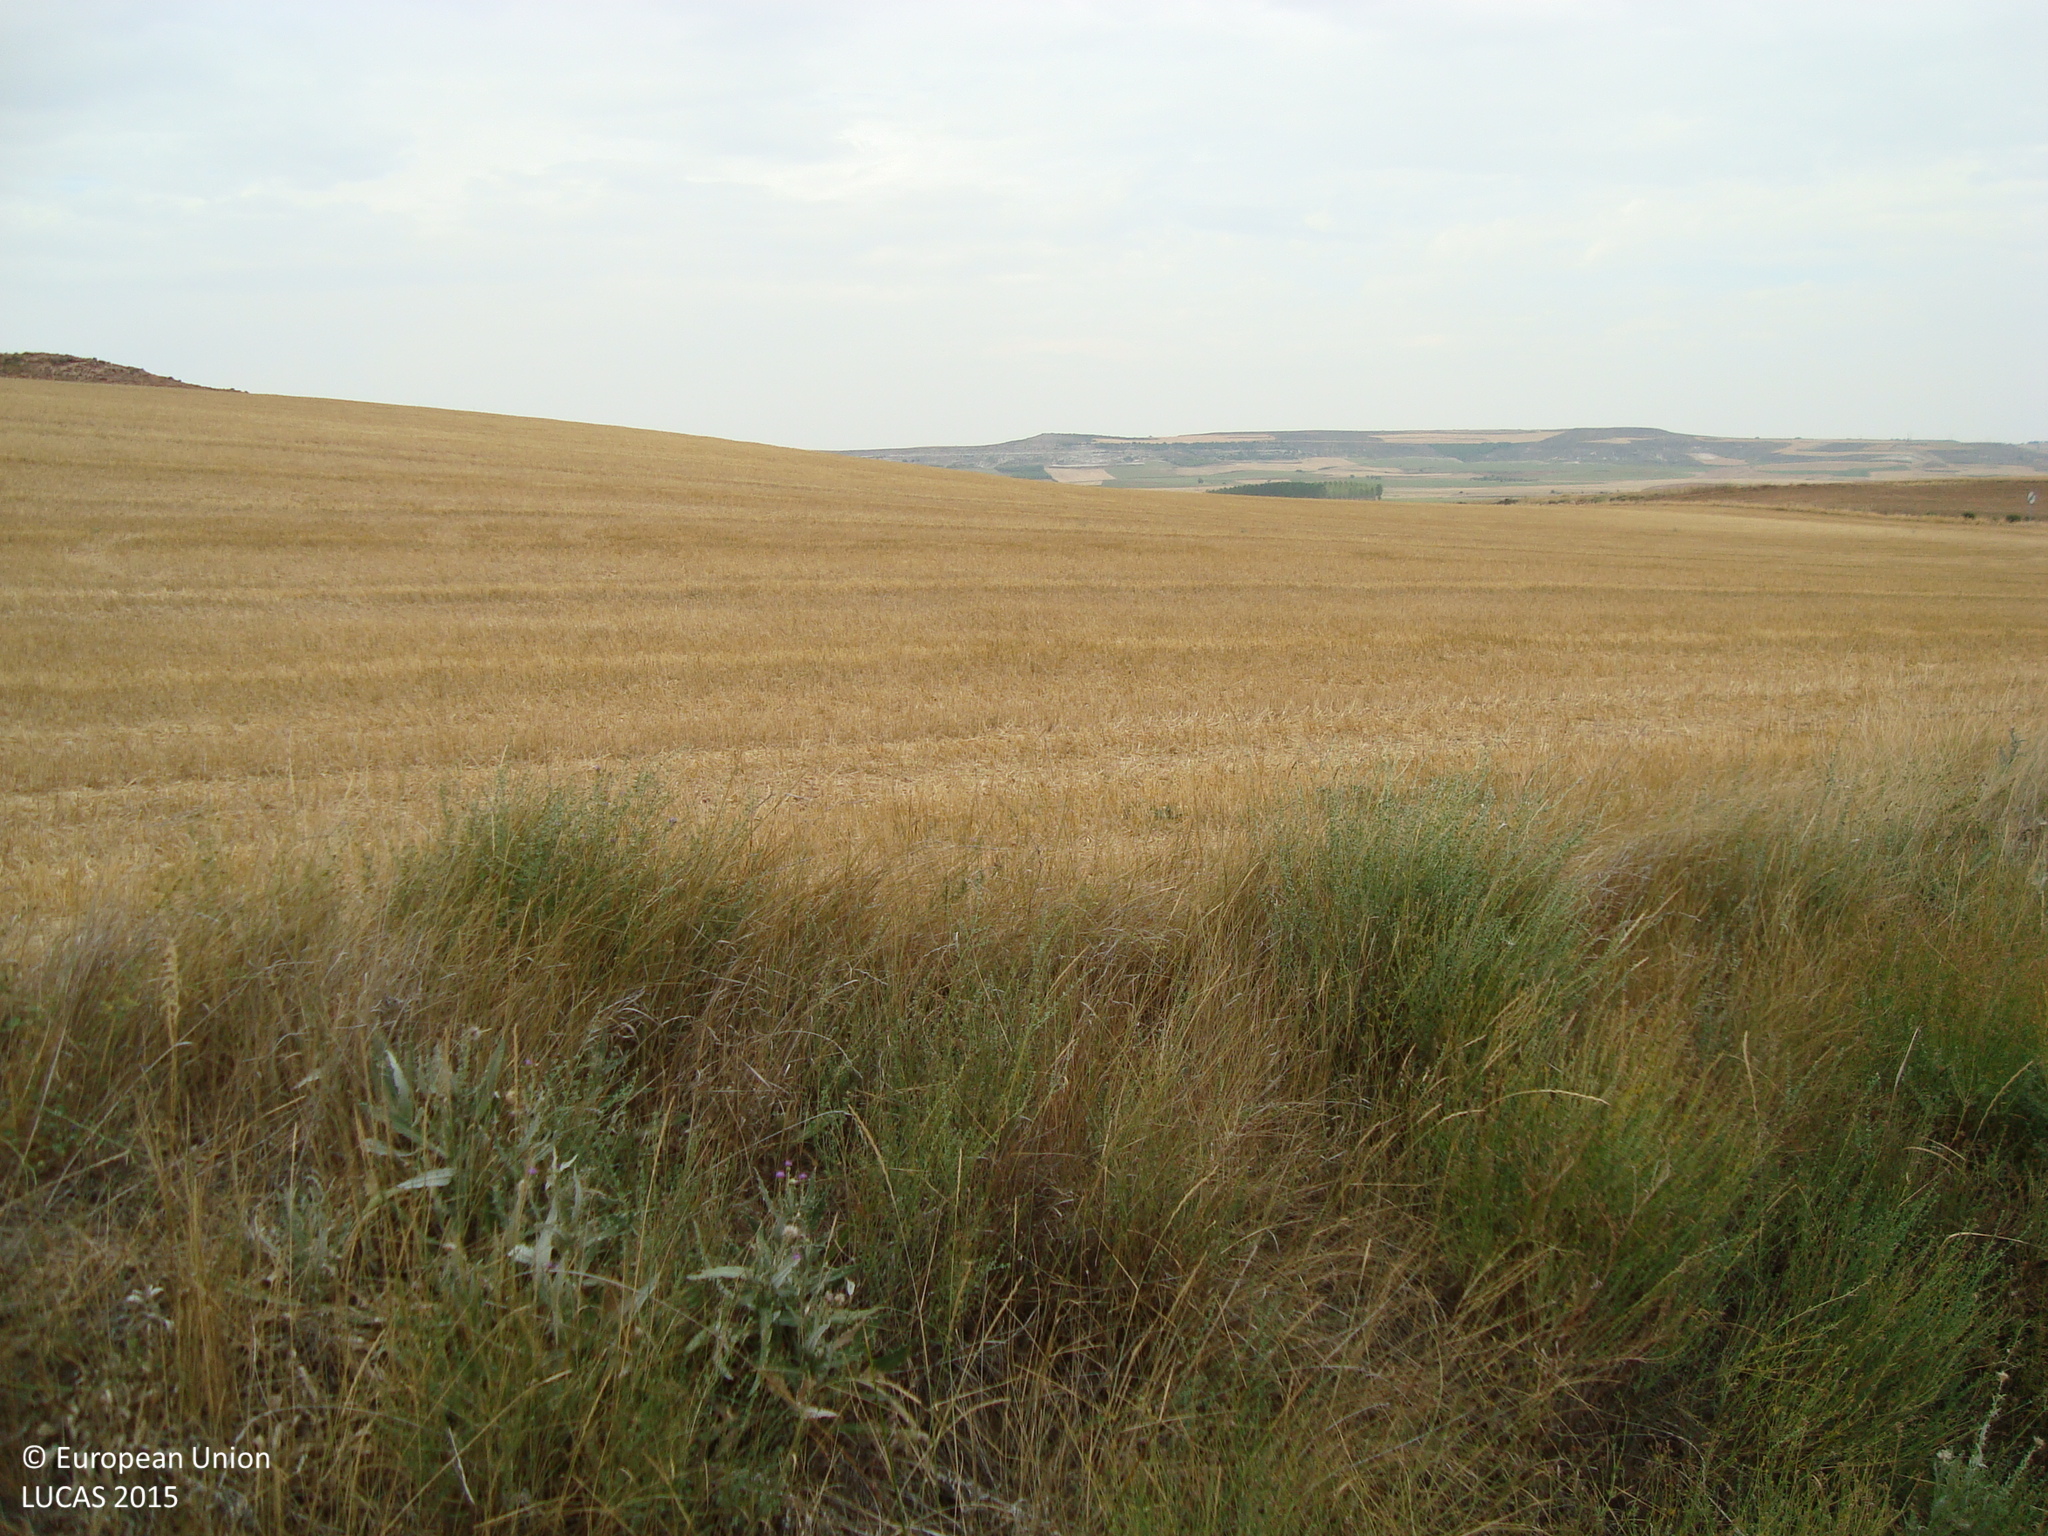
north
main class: Cropland
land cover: Barley
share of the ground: > 75 %
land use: Agriculture (excluding fallow land and kitchen gardens)
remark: Harvested field
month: August
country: ES
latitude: 42.1743
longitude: -3.9725
